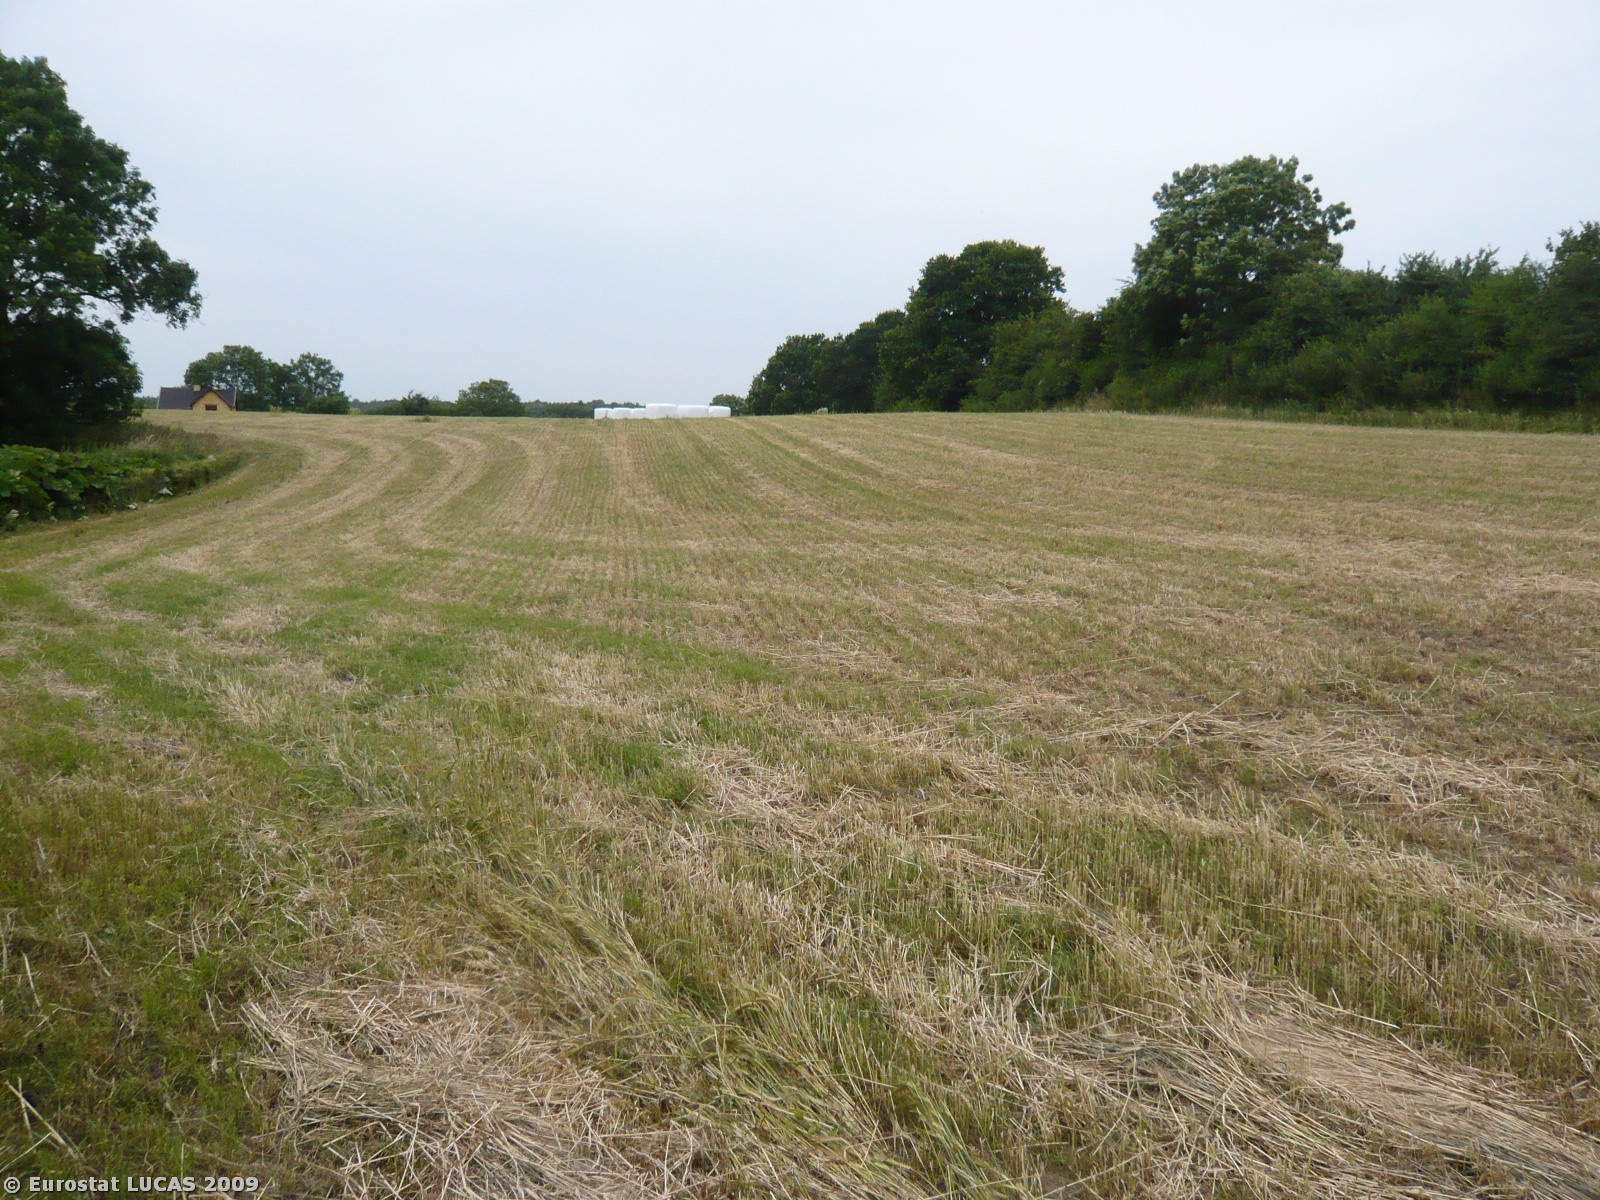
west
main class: Grassland
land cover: Grassland without tree/shrub cover
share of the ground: > 75 %
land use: Agriculture (excluding fallow land and kitchen gardens)
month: July
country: DK
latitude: 55.5285
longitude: 11.7570
